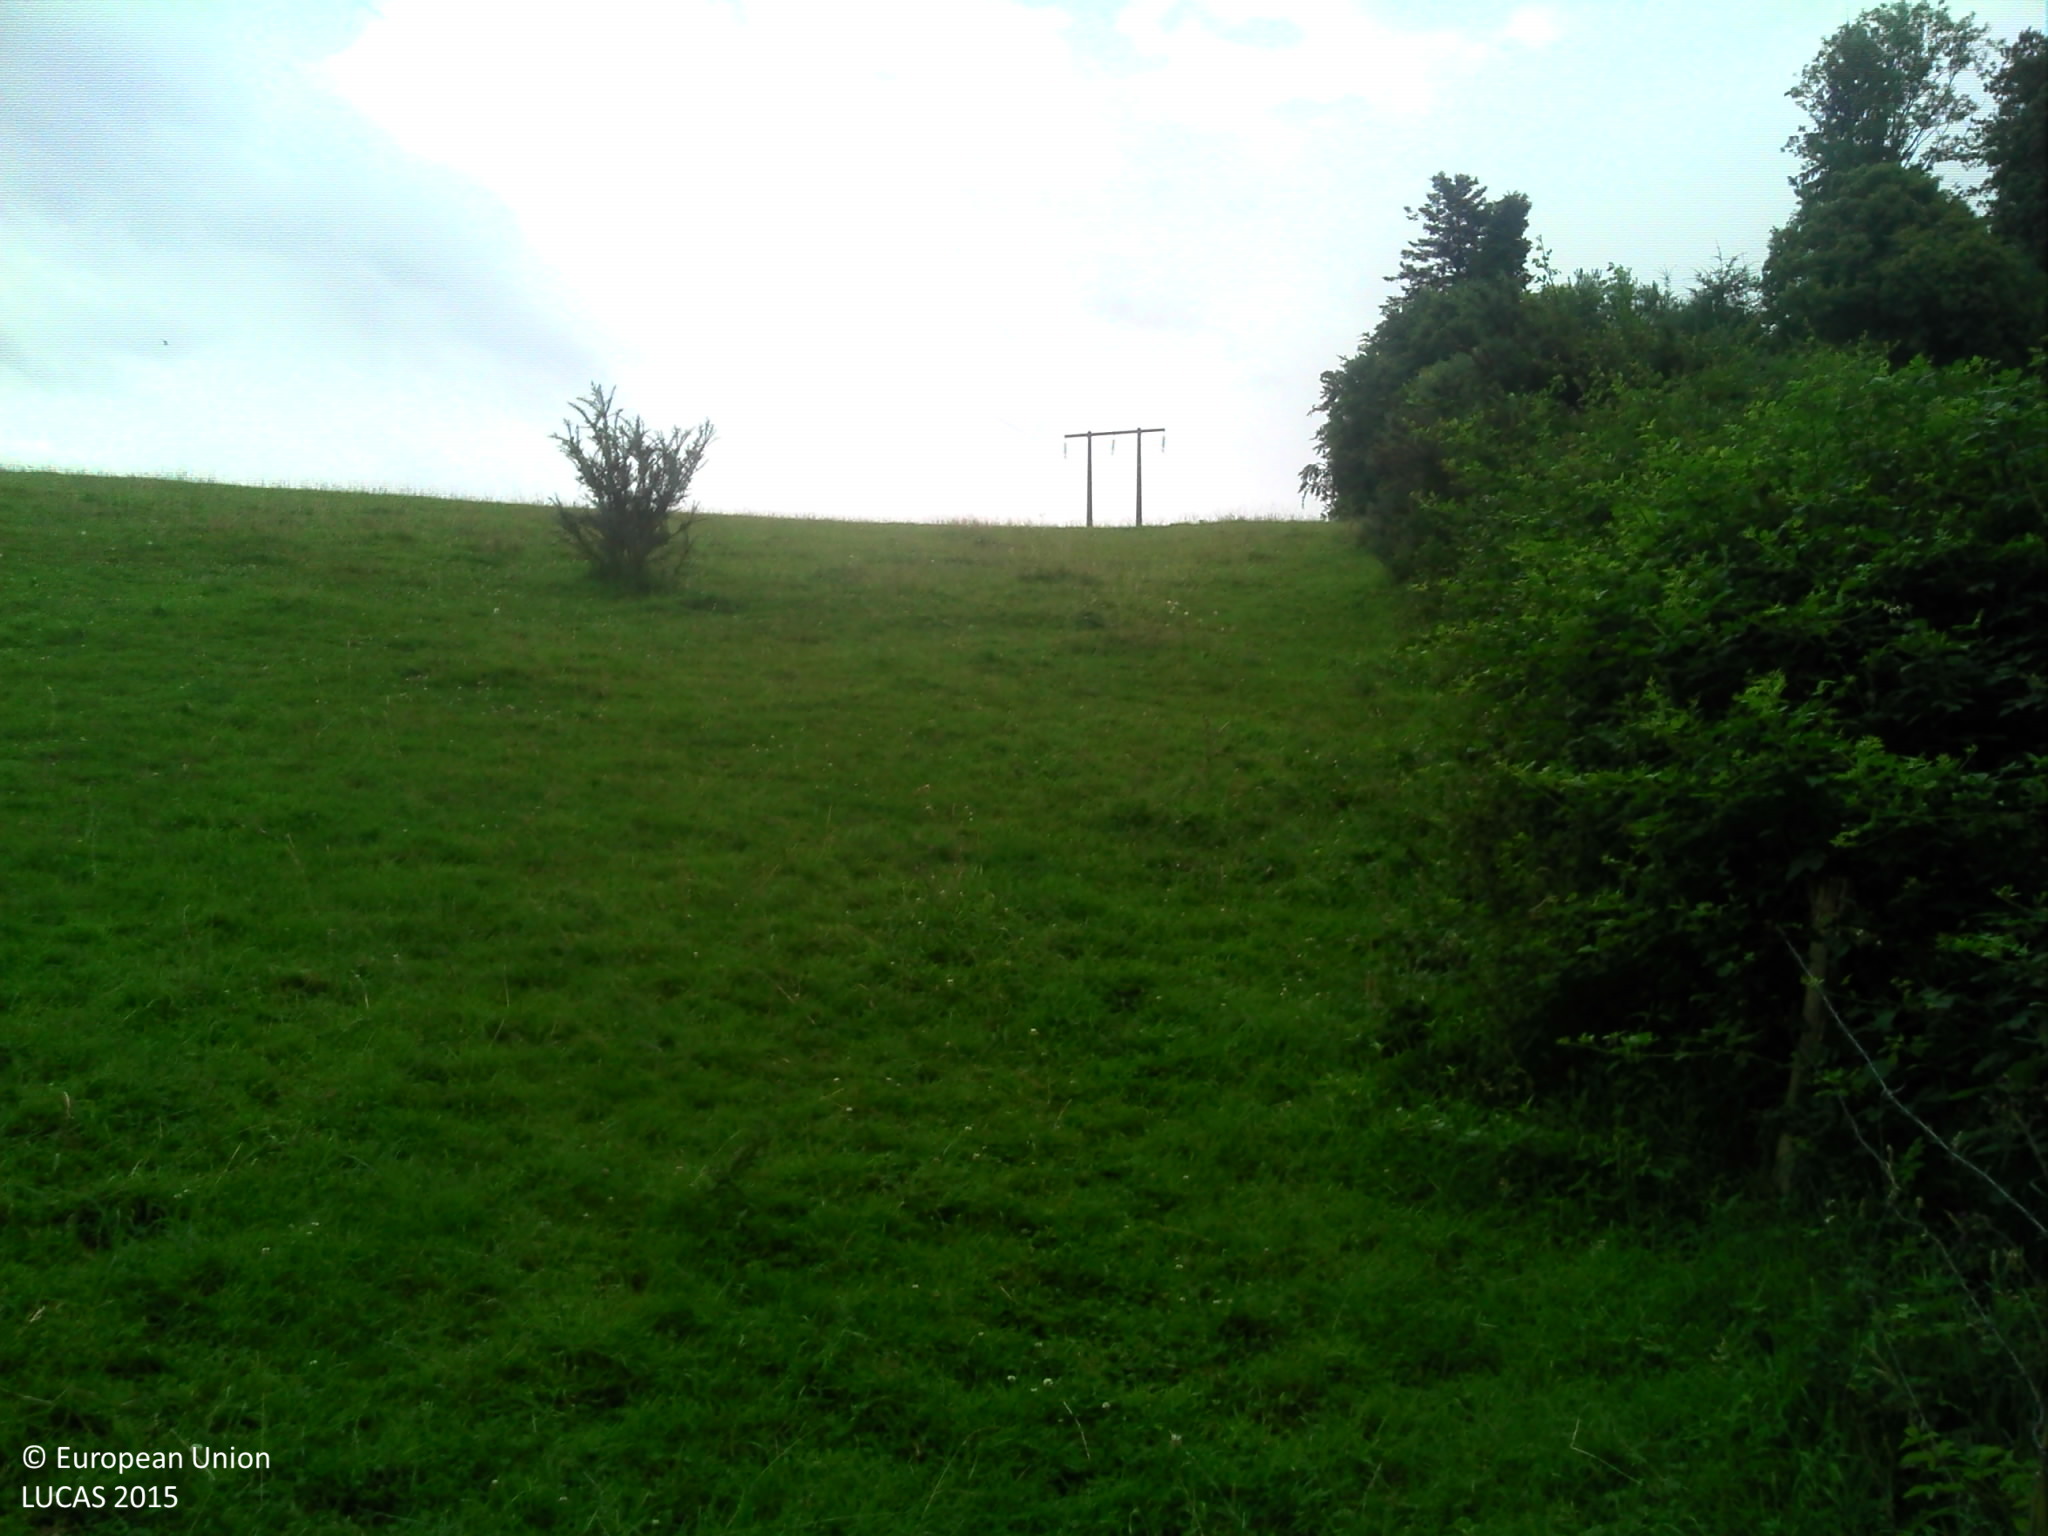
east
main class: Grassland
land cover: Grassland without tree/shrub cover
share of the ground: > 75 %
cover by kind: herbaceous plants 100 %
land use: Agriculture (excluding fallow land and kitchen gardens)
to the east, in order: Fences; Grassland without tree/shrub cover; Electric lines; Grassland without tree/shrub cover; Rivers and streams; Broadleaved woodland; Grassland without tree/shrub cover
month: July
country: FR
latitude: 48.7589
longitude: -1.3776
